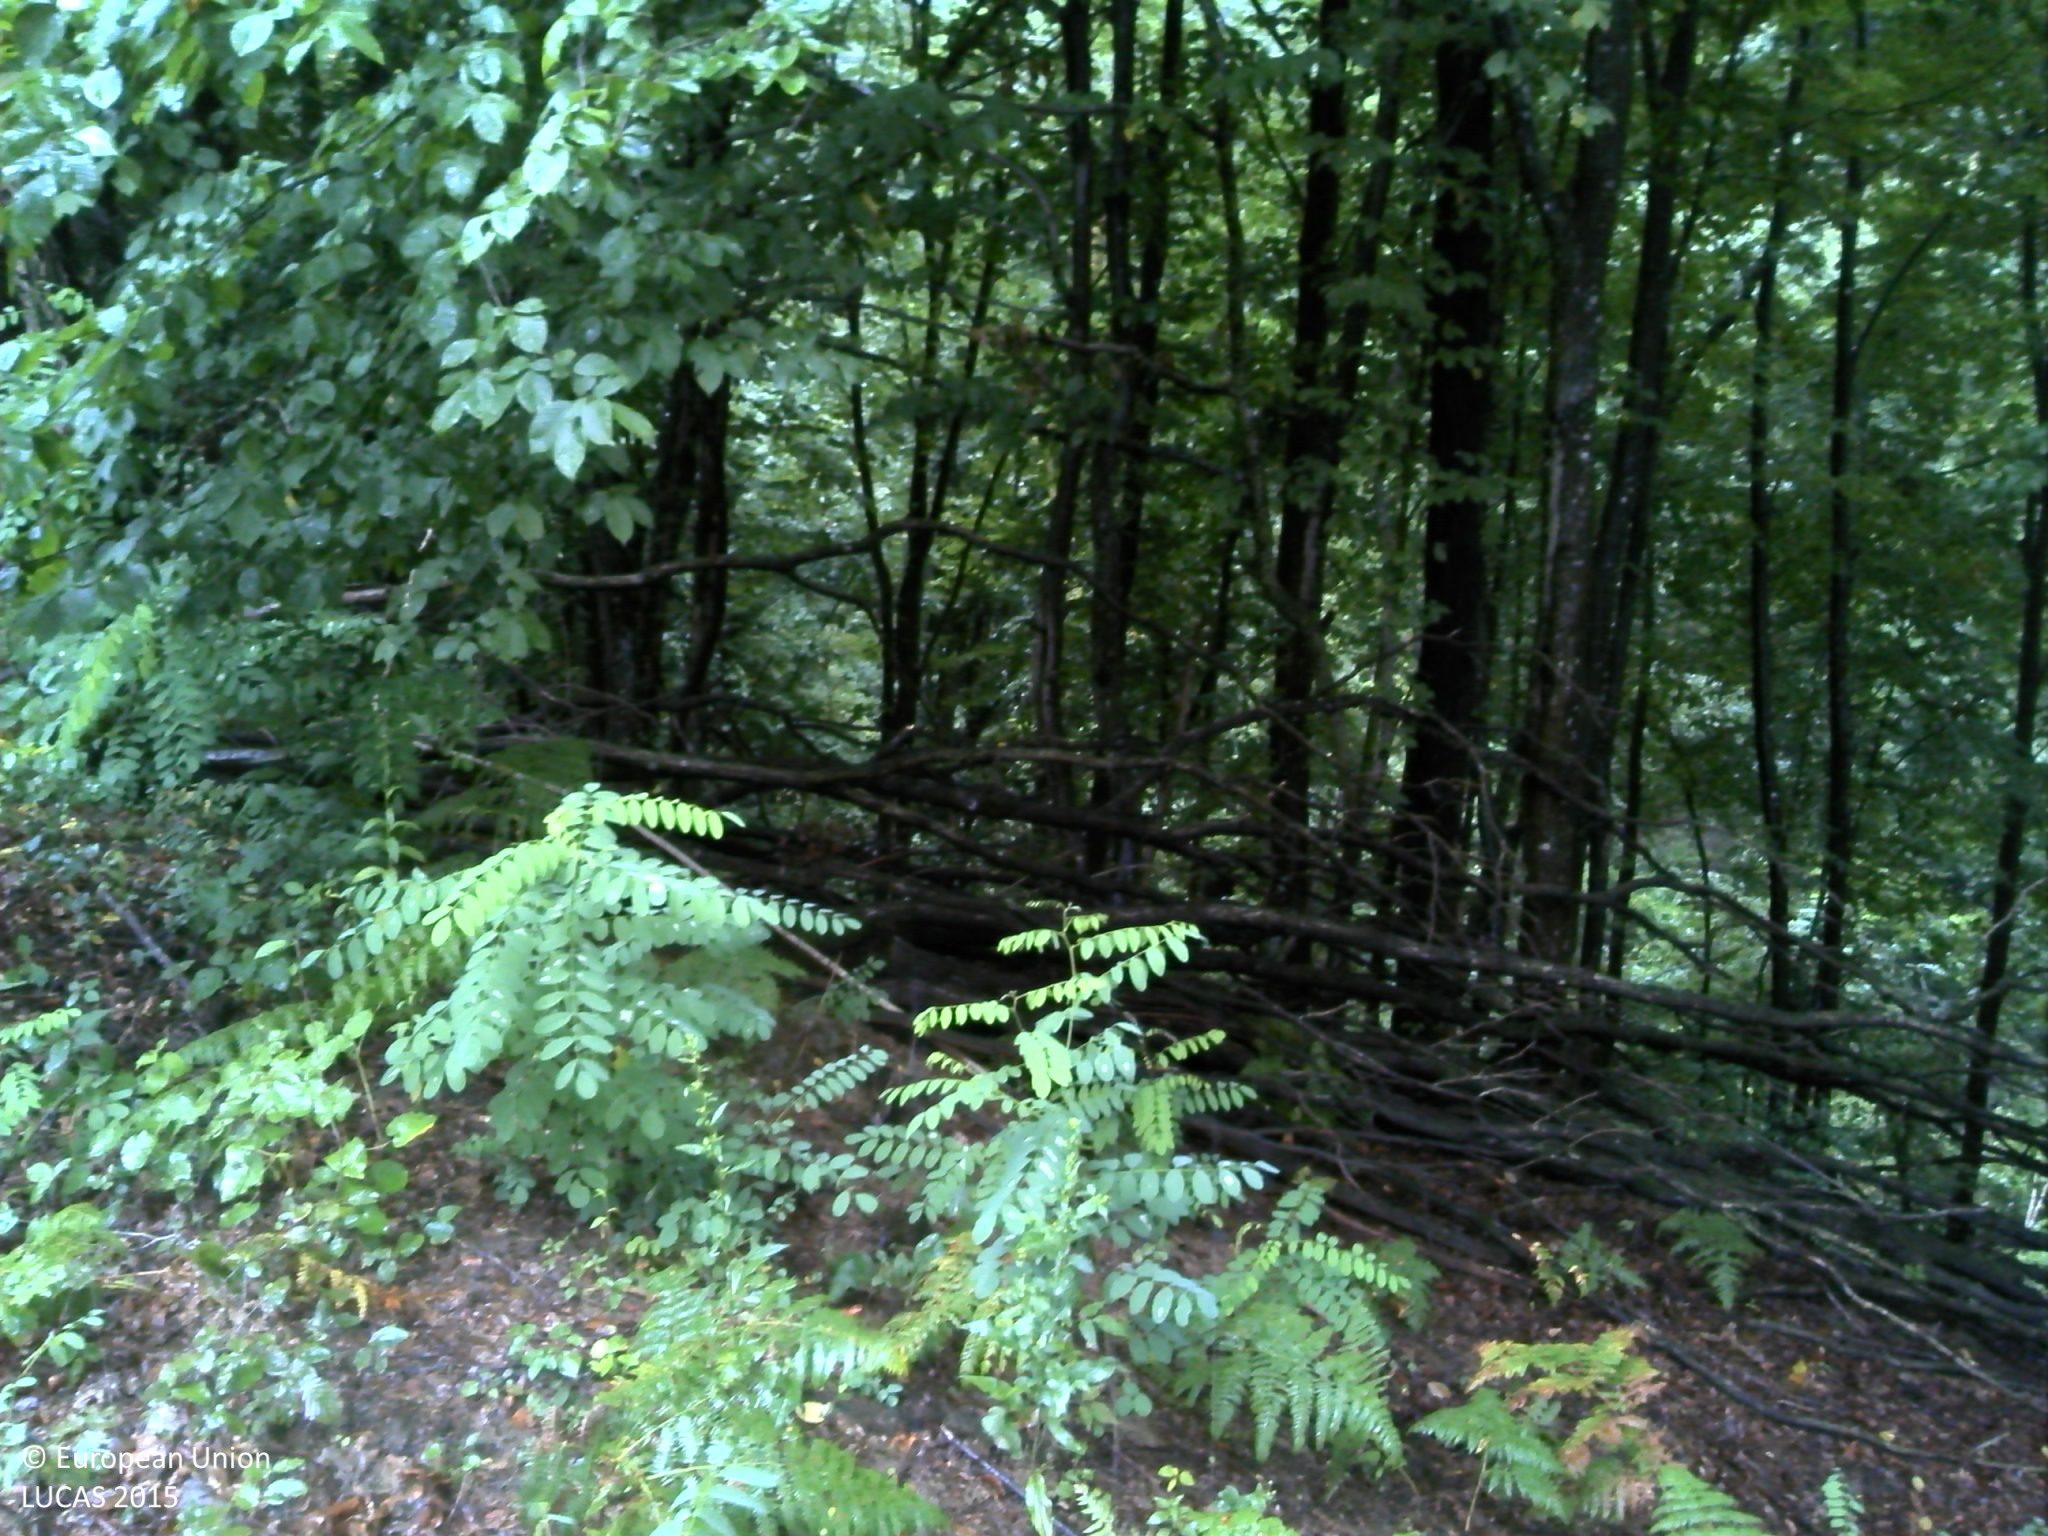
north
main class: Woodland
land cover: Broadleaved woodland
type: beech forest
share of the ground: > 75 %
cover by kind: broadleaved forest trees 100 %
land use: Forestry
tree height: > 5 m
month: August
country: HR
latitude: 45.4761
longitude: 15.7146
